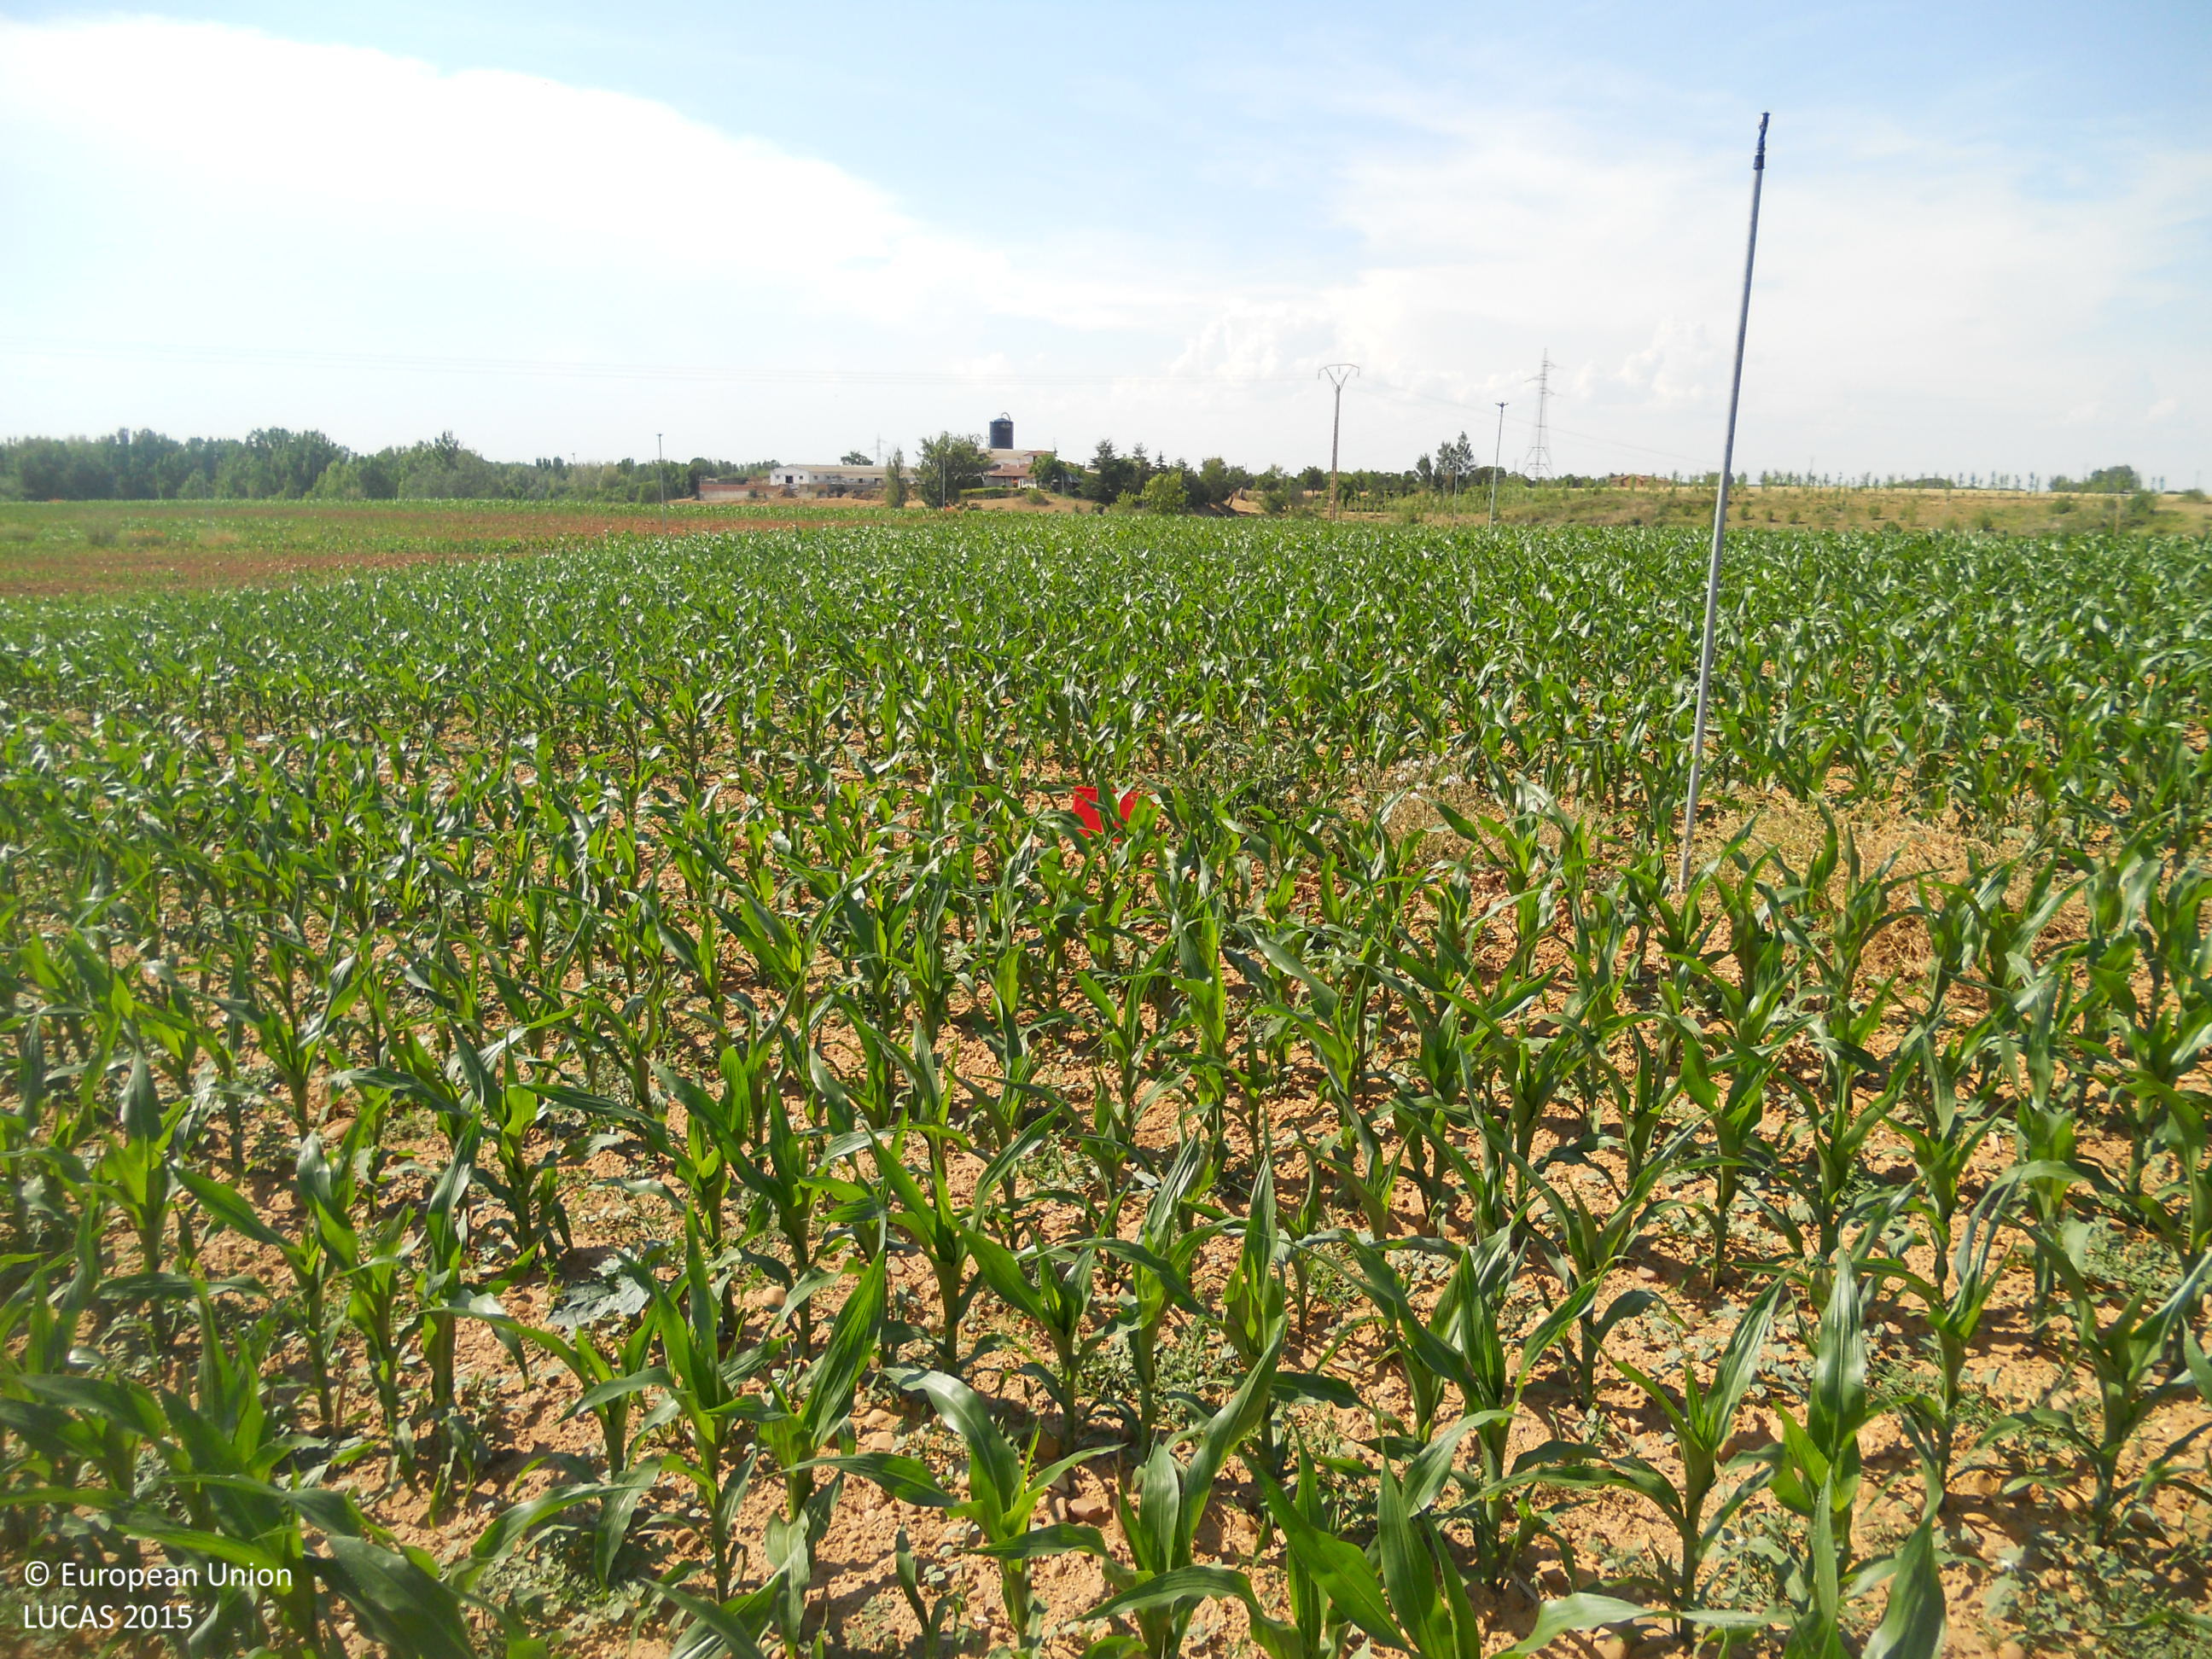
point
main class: Cropland
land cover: Maize
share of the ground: 10 - 25 %
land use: Agriculture (excluding fallow land and kitchen gardens)
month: June
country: ES
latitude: 42.2565
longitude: -5.5227
